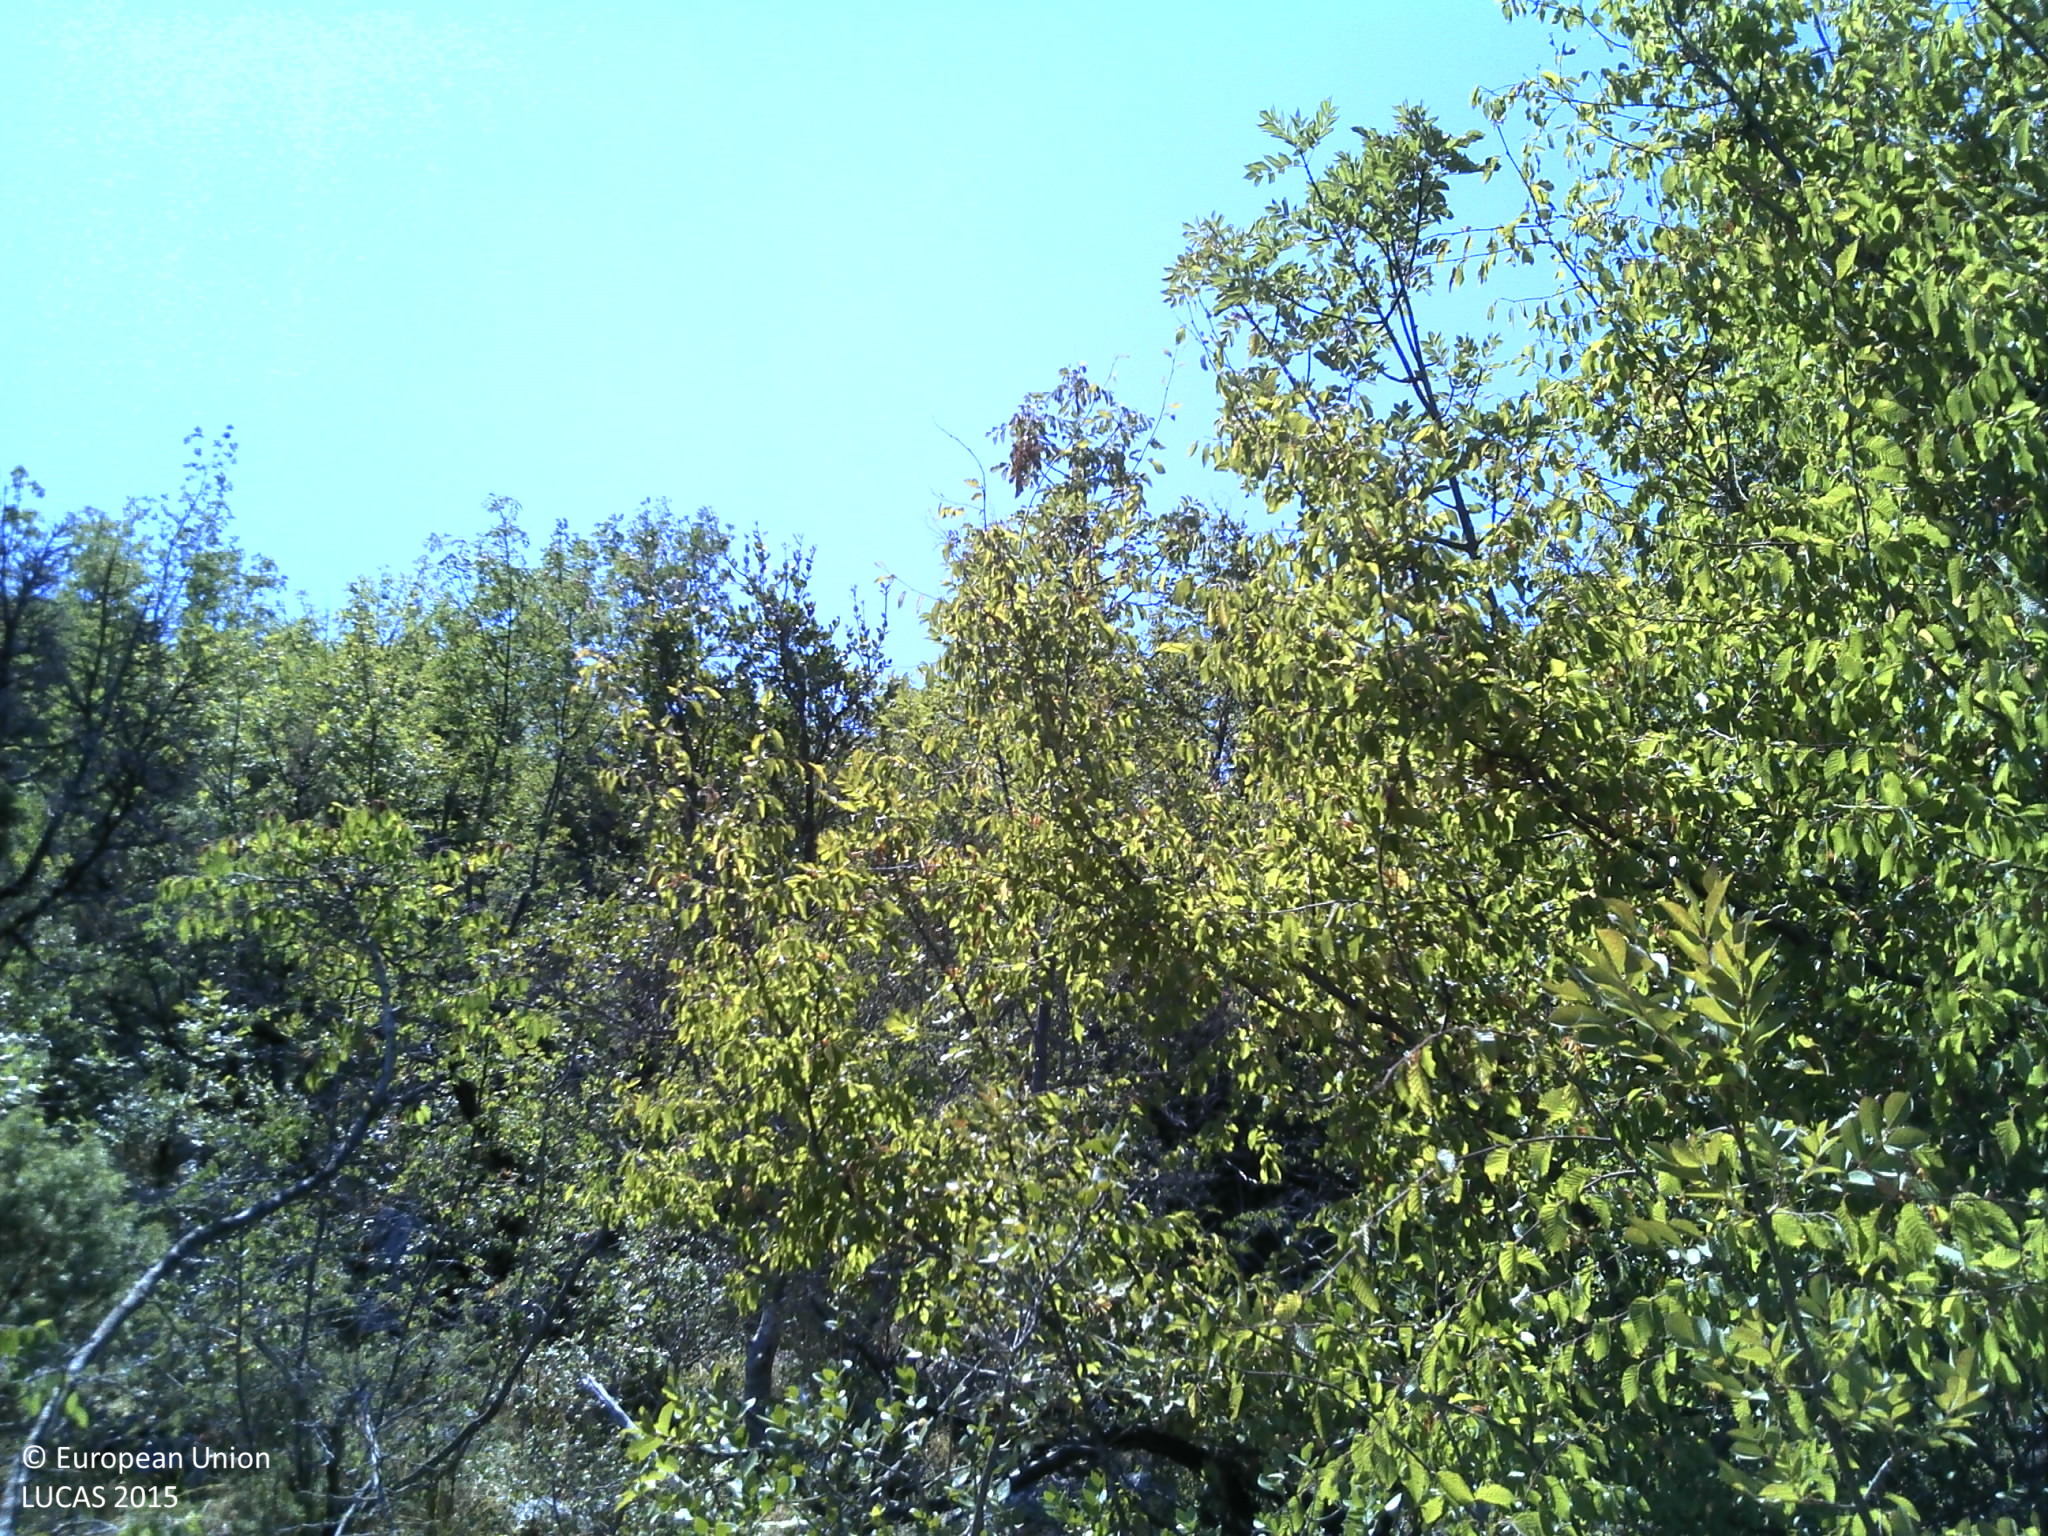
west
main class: Woodland
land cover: Other mixed woodland
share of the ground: > 75 %
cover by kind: broadleaved forest trees 30 %, unconsolidated bare surface 30 %, shrubs 25 %, coniferous forest trees 15 %
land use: Semi-natural and natural areas not in use
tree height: < 5 m
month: July
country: HR
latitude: 43.0145
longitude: 17.6840
